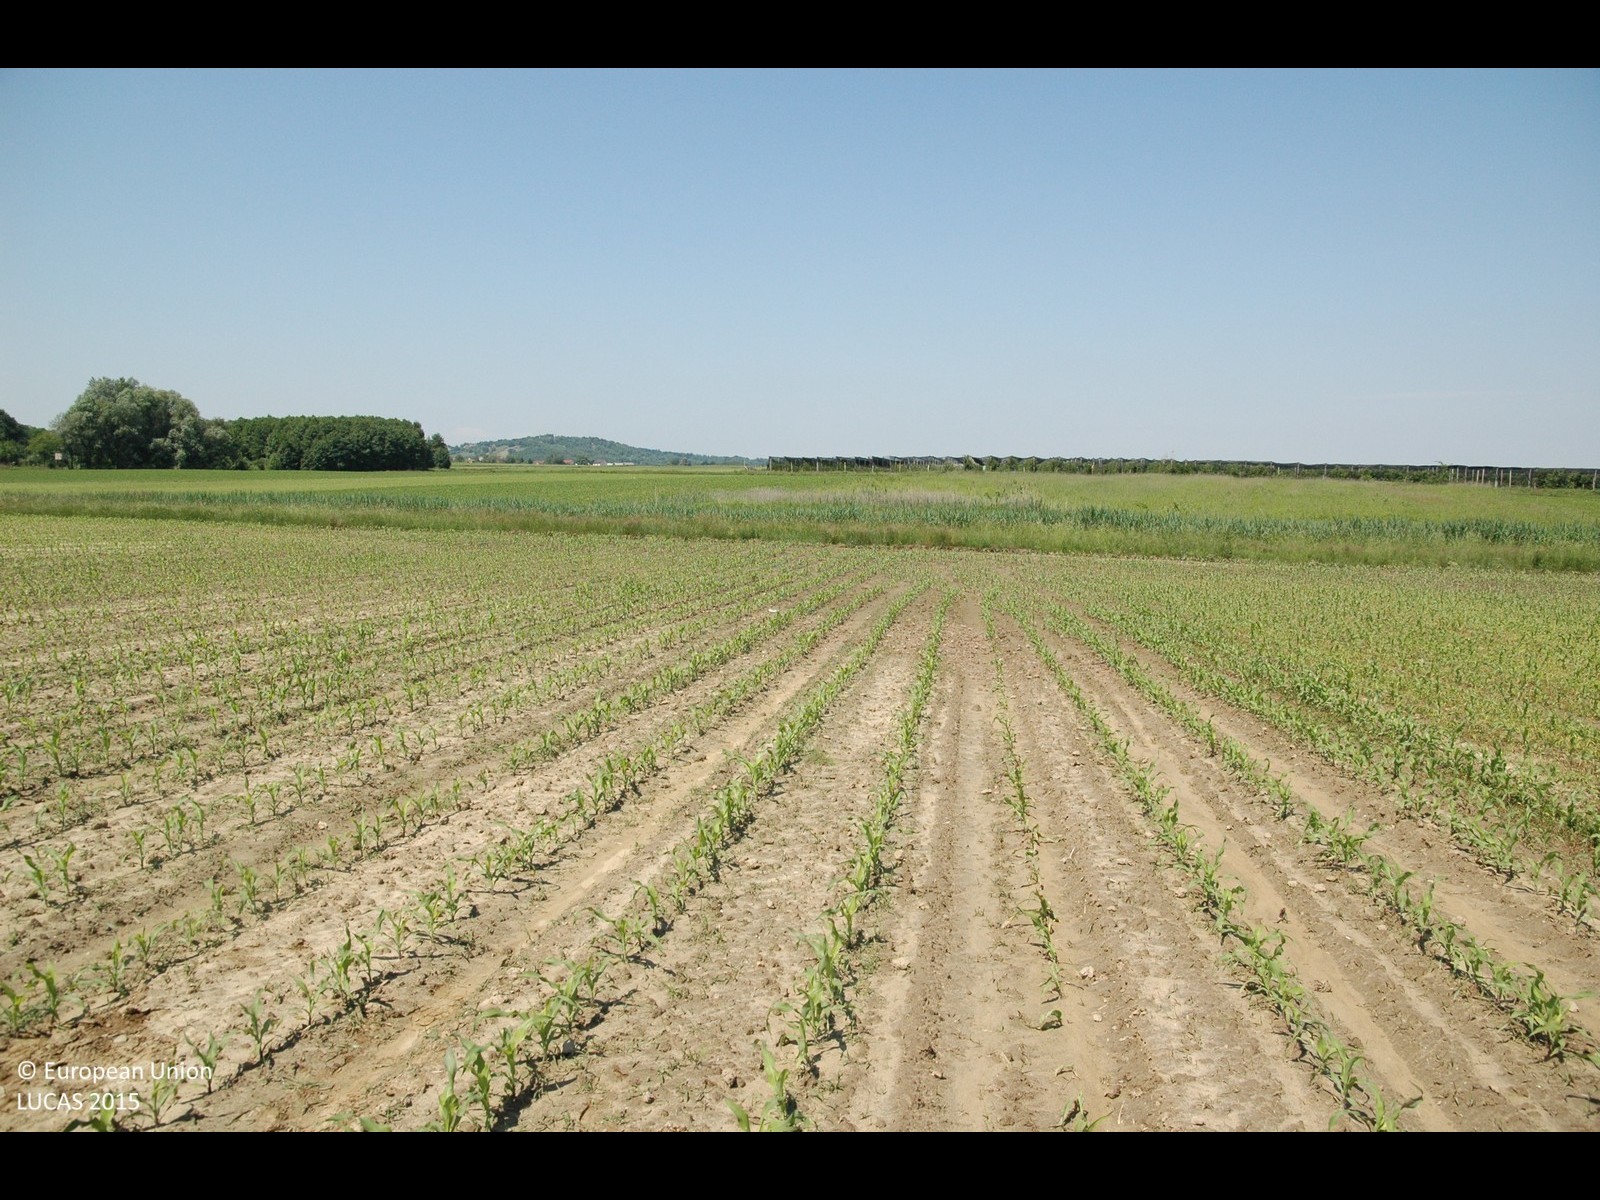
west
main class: Cropland
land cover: Maize
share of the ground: 25 - 50 %
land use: Agriculture (excluding fallow land and kitchen gardens)
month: May
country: HR
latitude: 46.5012
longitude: 16.4250
